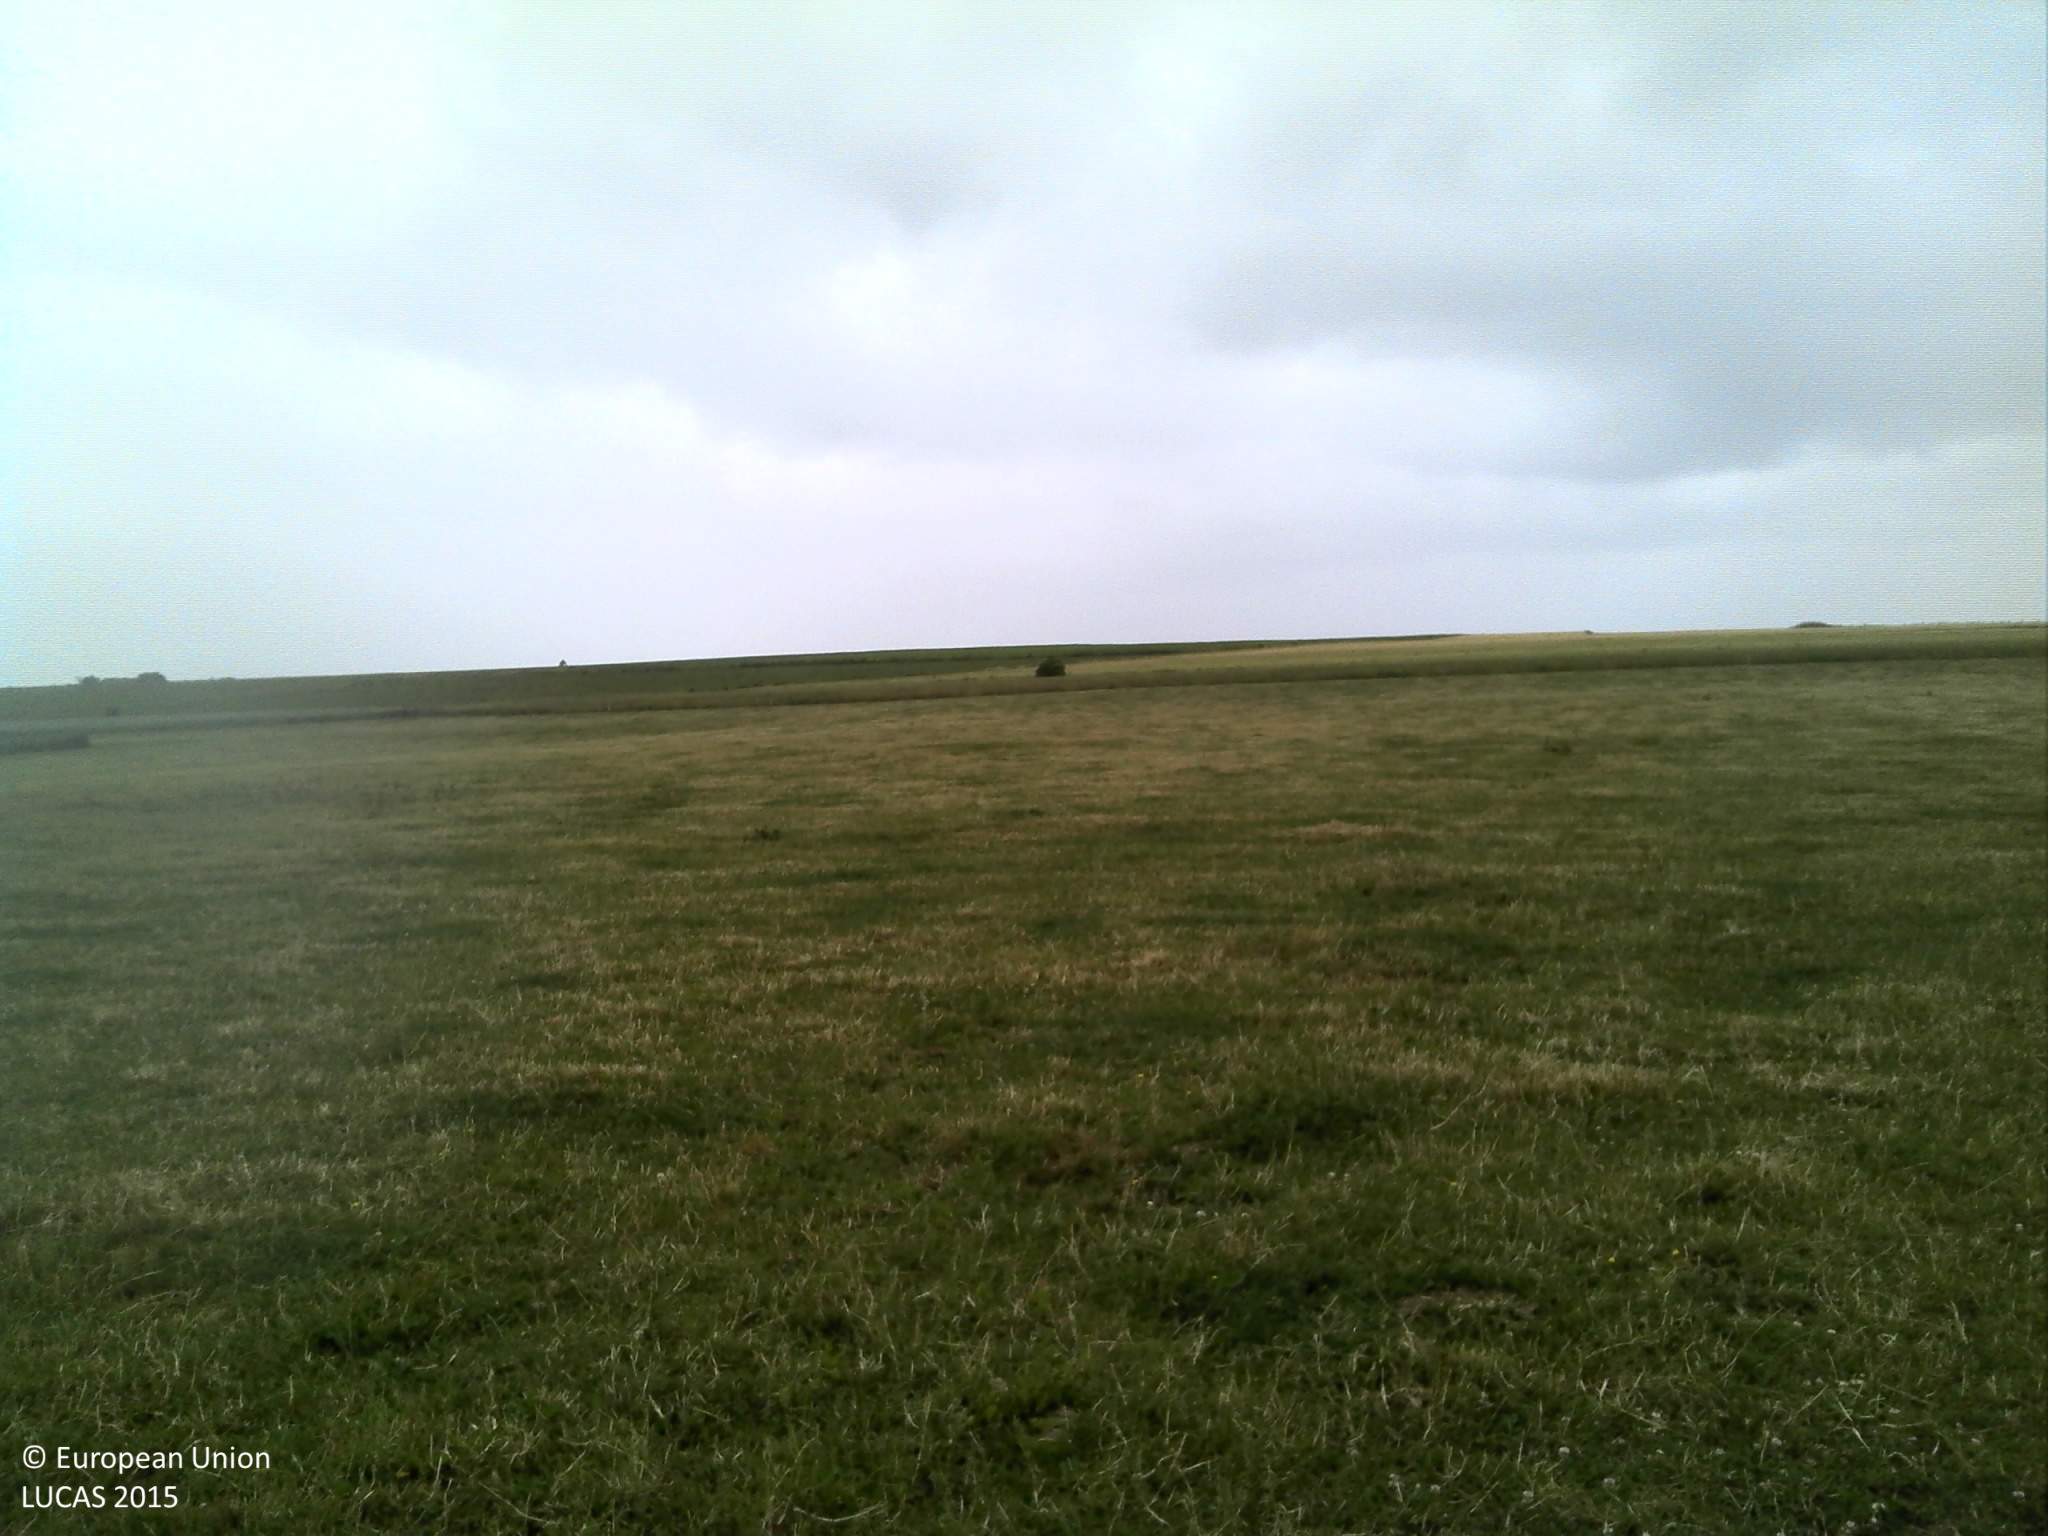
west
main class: Grassland
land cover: Grassland without tree/shrub cover
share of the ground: > 75 %
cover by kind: herbaceous plants 100 %
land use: Agriculture (excluding fallow land and kitchen gardens)
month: July
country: LU
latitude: 50.0937
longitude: 5.9313
